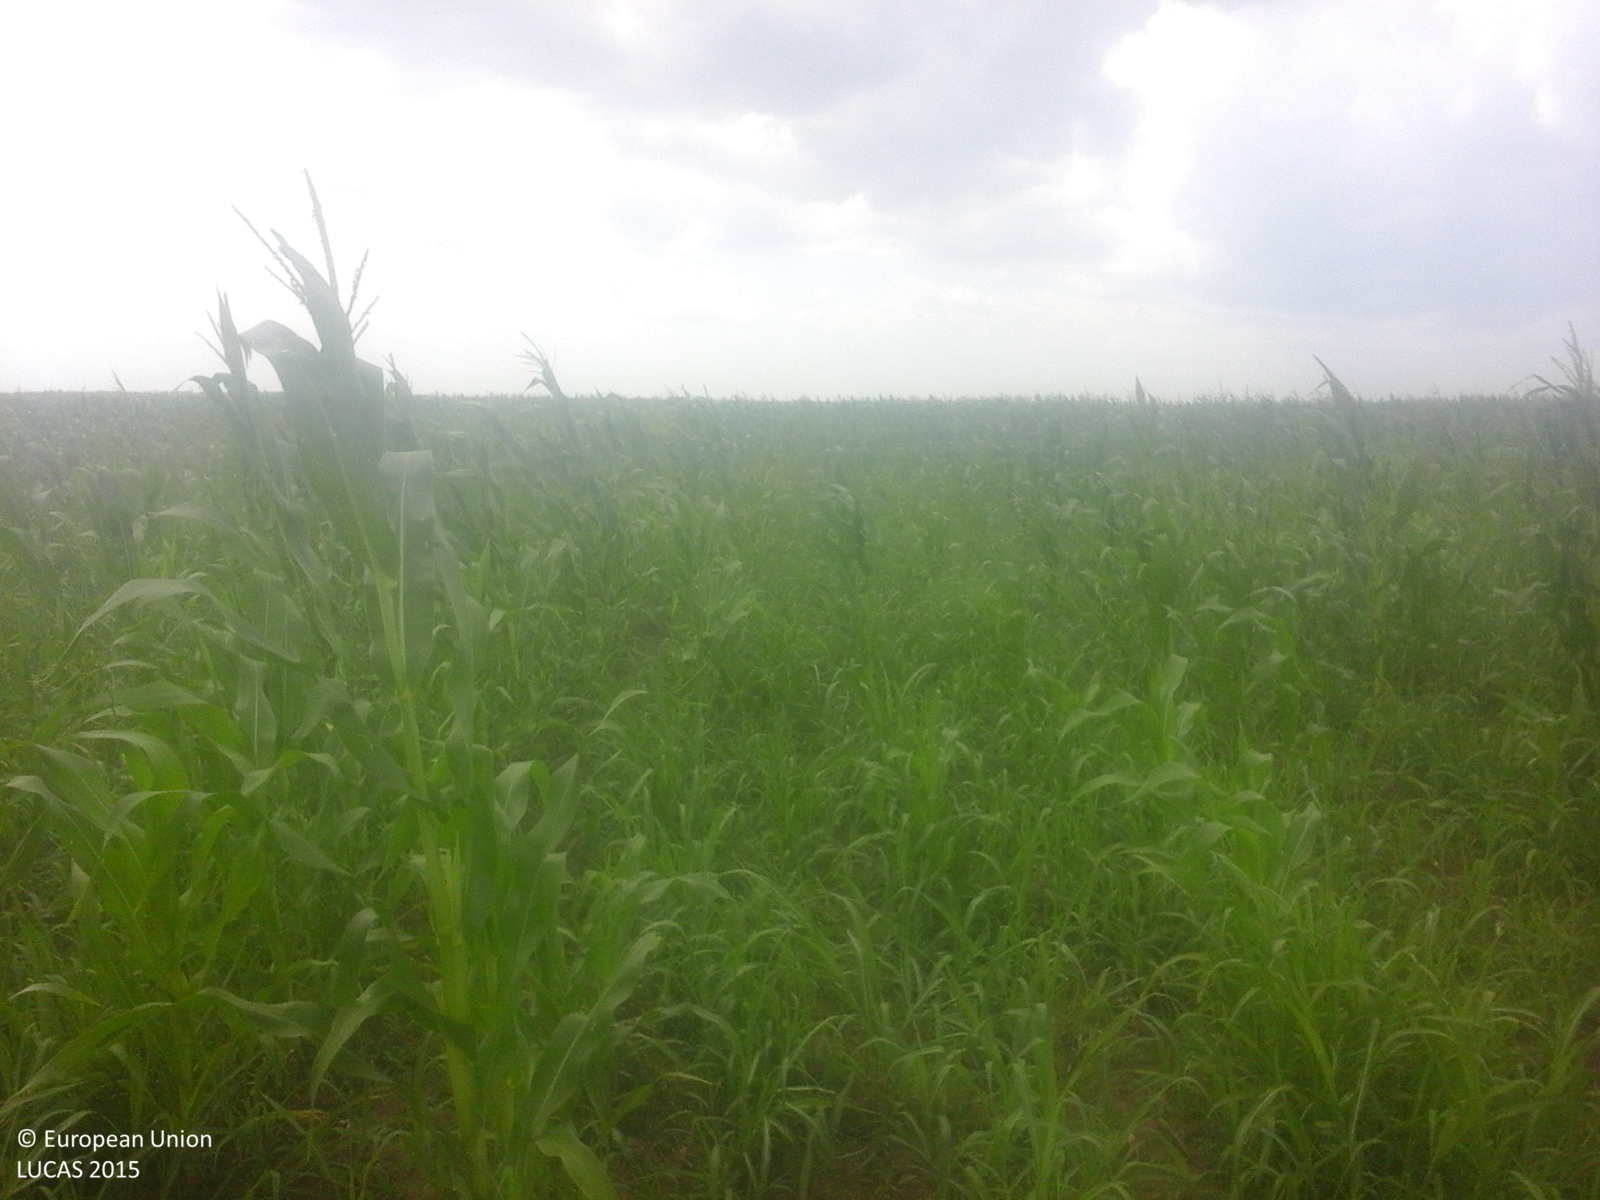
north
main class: Cropland
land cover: Maize
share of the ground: > 75 %
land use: Agriculture (excluding fallow land and kitchen gardens)
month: July
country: RO
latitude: 43.7988
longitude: 24.5198
